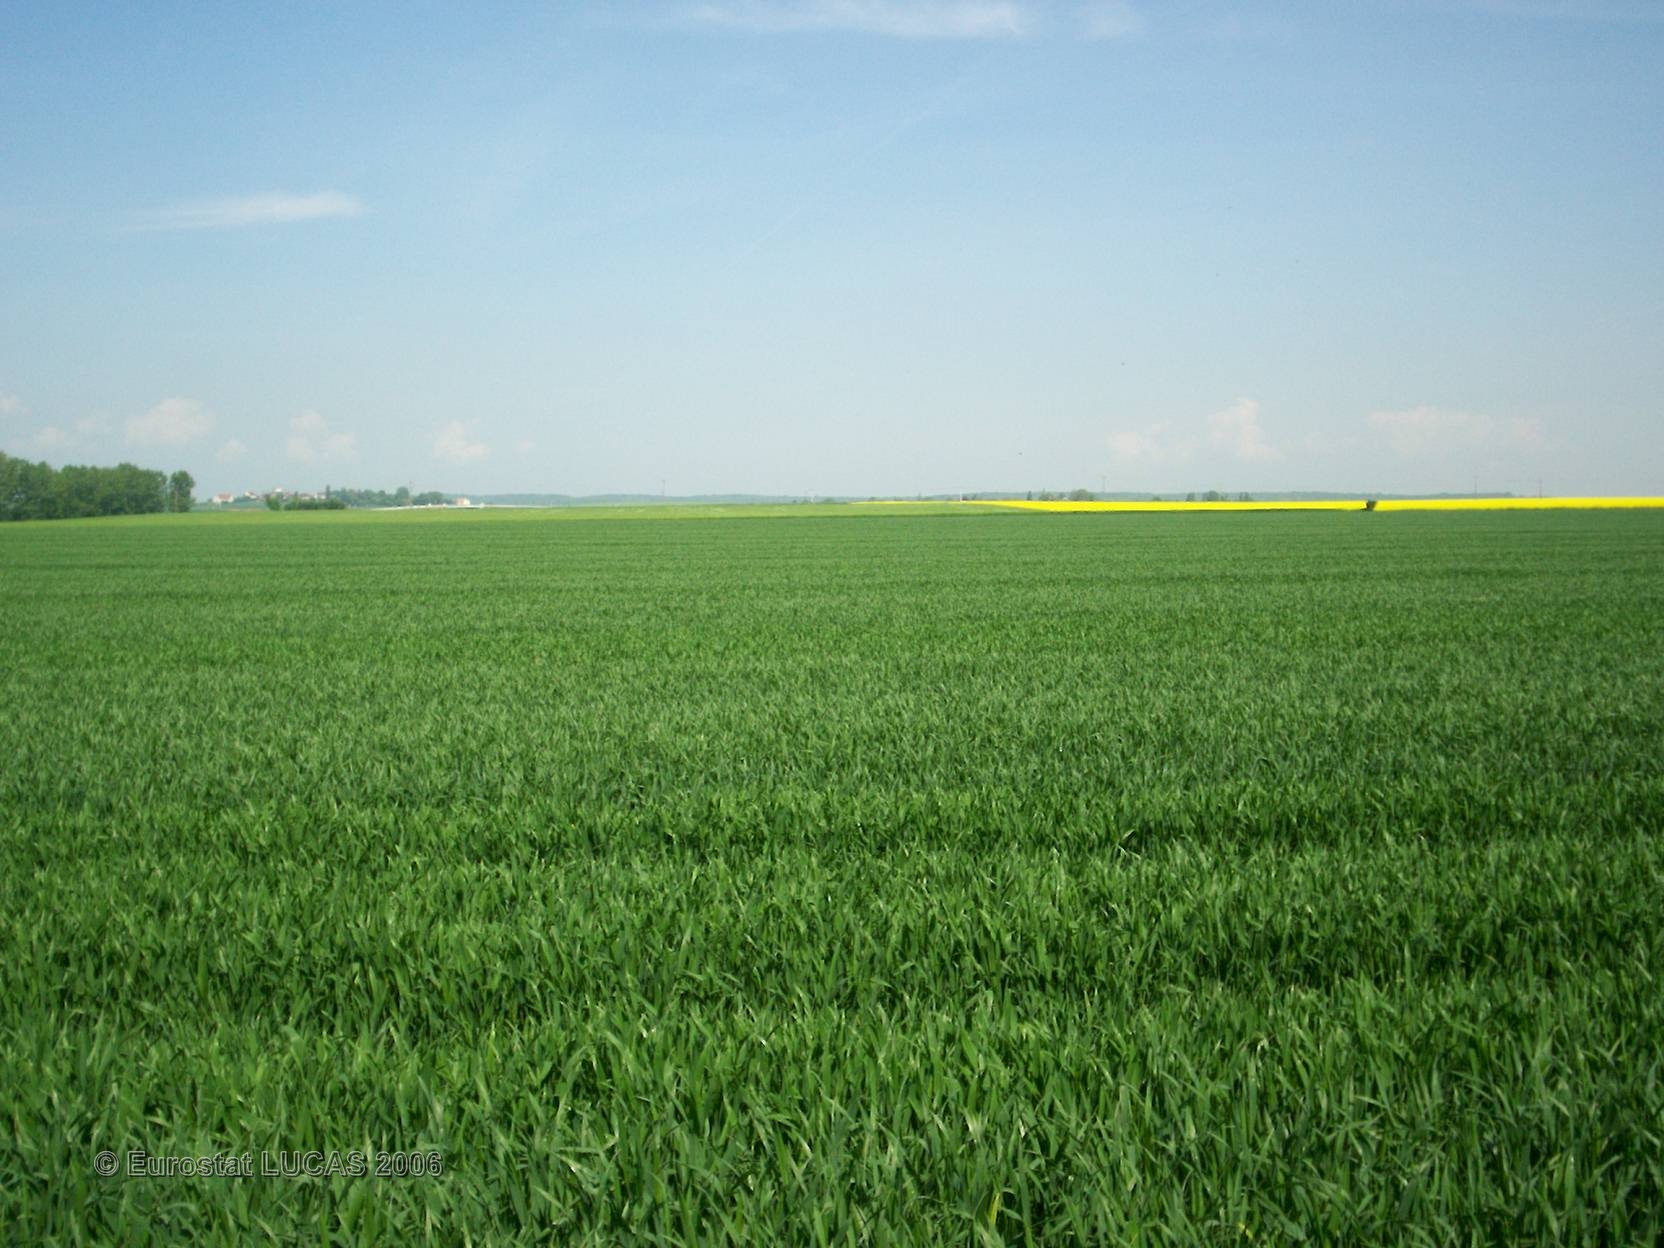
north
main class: Cropland
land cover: Common wheat
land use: Agriculture (excluding fallow land and kitchen gardens)
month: May
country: FR
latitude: 48.9807
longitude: 2.7894
